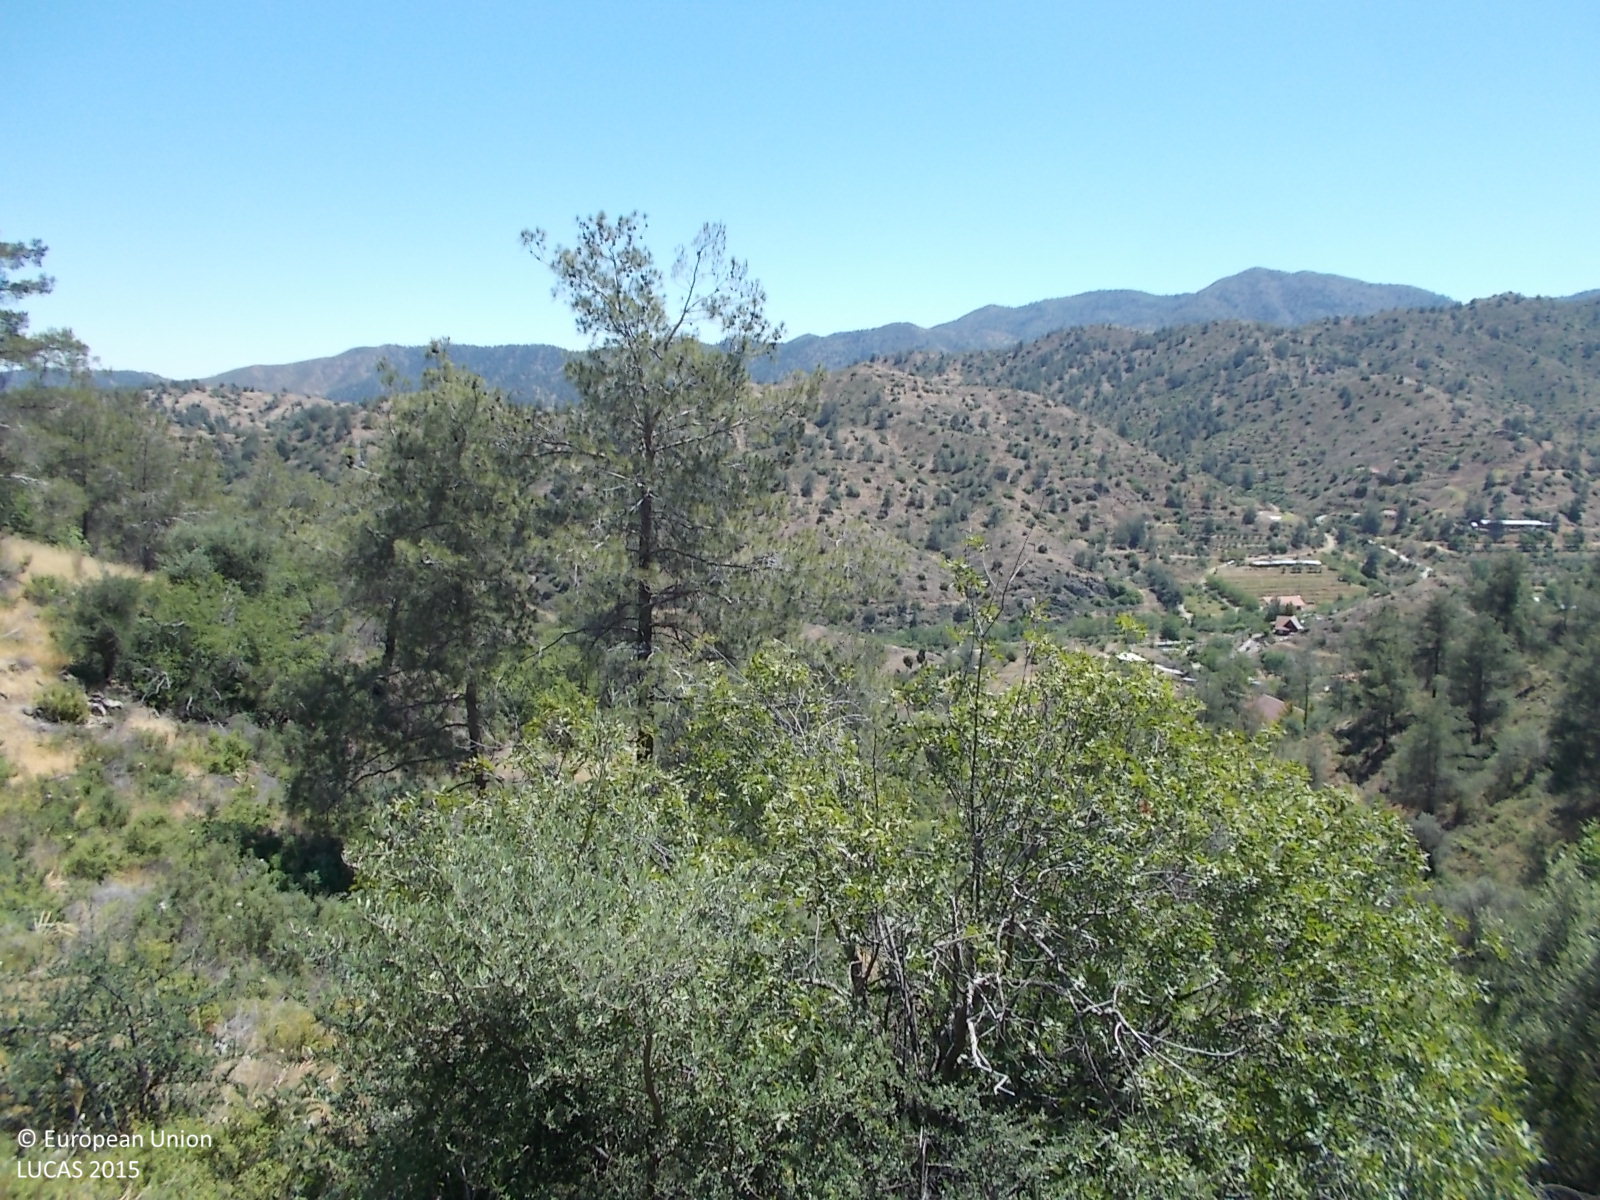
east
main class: Shrubland
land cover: Shrubland with sparse tree cover
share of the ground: > 75 %
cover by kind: shrubs 95 %, broadleaved forest trees 5 %
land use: Semi-natural and natural areas not in use
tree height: < 5 m
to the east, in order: Shrubland with sparse tree cover; Nuts trees; Shrubland with sparse tree cover; Pine dominated coniferous woodland; Shrubland with sparse tree cover; Ditches and canals; Olive groves; Other fruit trees and berries; Nuts trees; Grass margins; Other bare soil; Grass margins; Other fresh vegetables; Lines of trees; Other fresh vegetables; Grass margins; Nuts trees; Grass margins; Paved roads, cycling and walking lanes; Electric lines; Grassland without tree/shrub cover; Other fresh vegetables; Vineyards; Nuts trees; Other fresh vegetables; Grass margins; Tracks
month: May
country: CY
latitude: 34.9687
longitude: 33.1233
